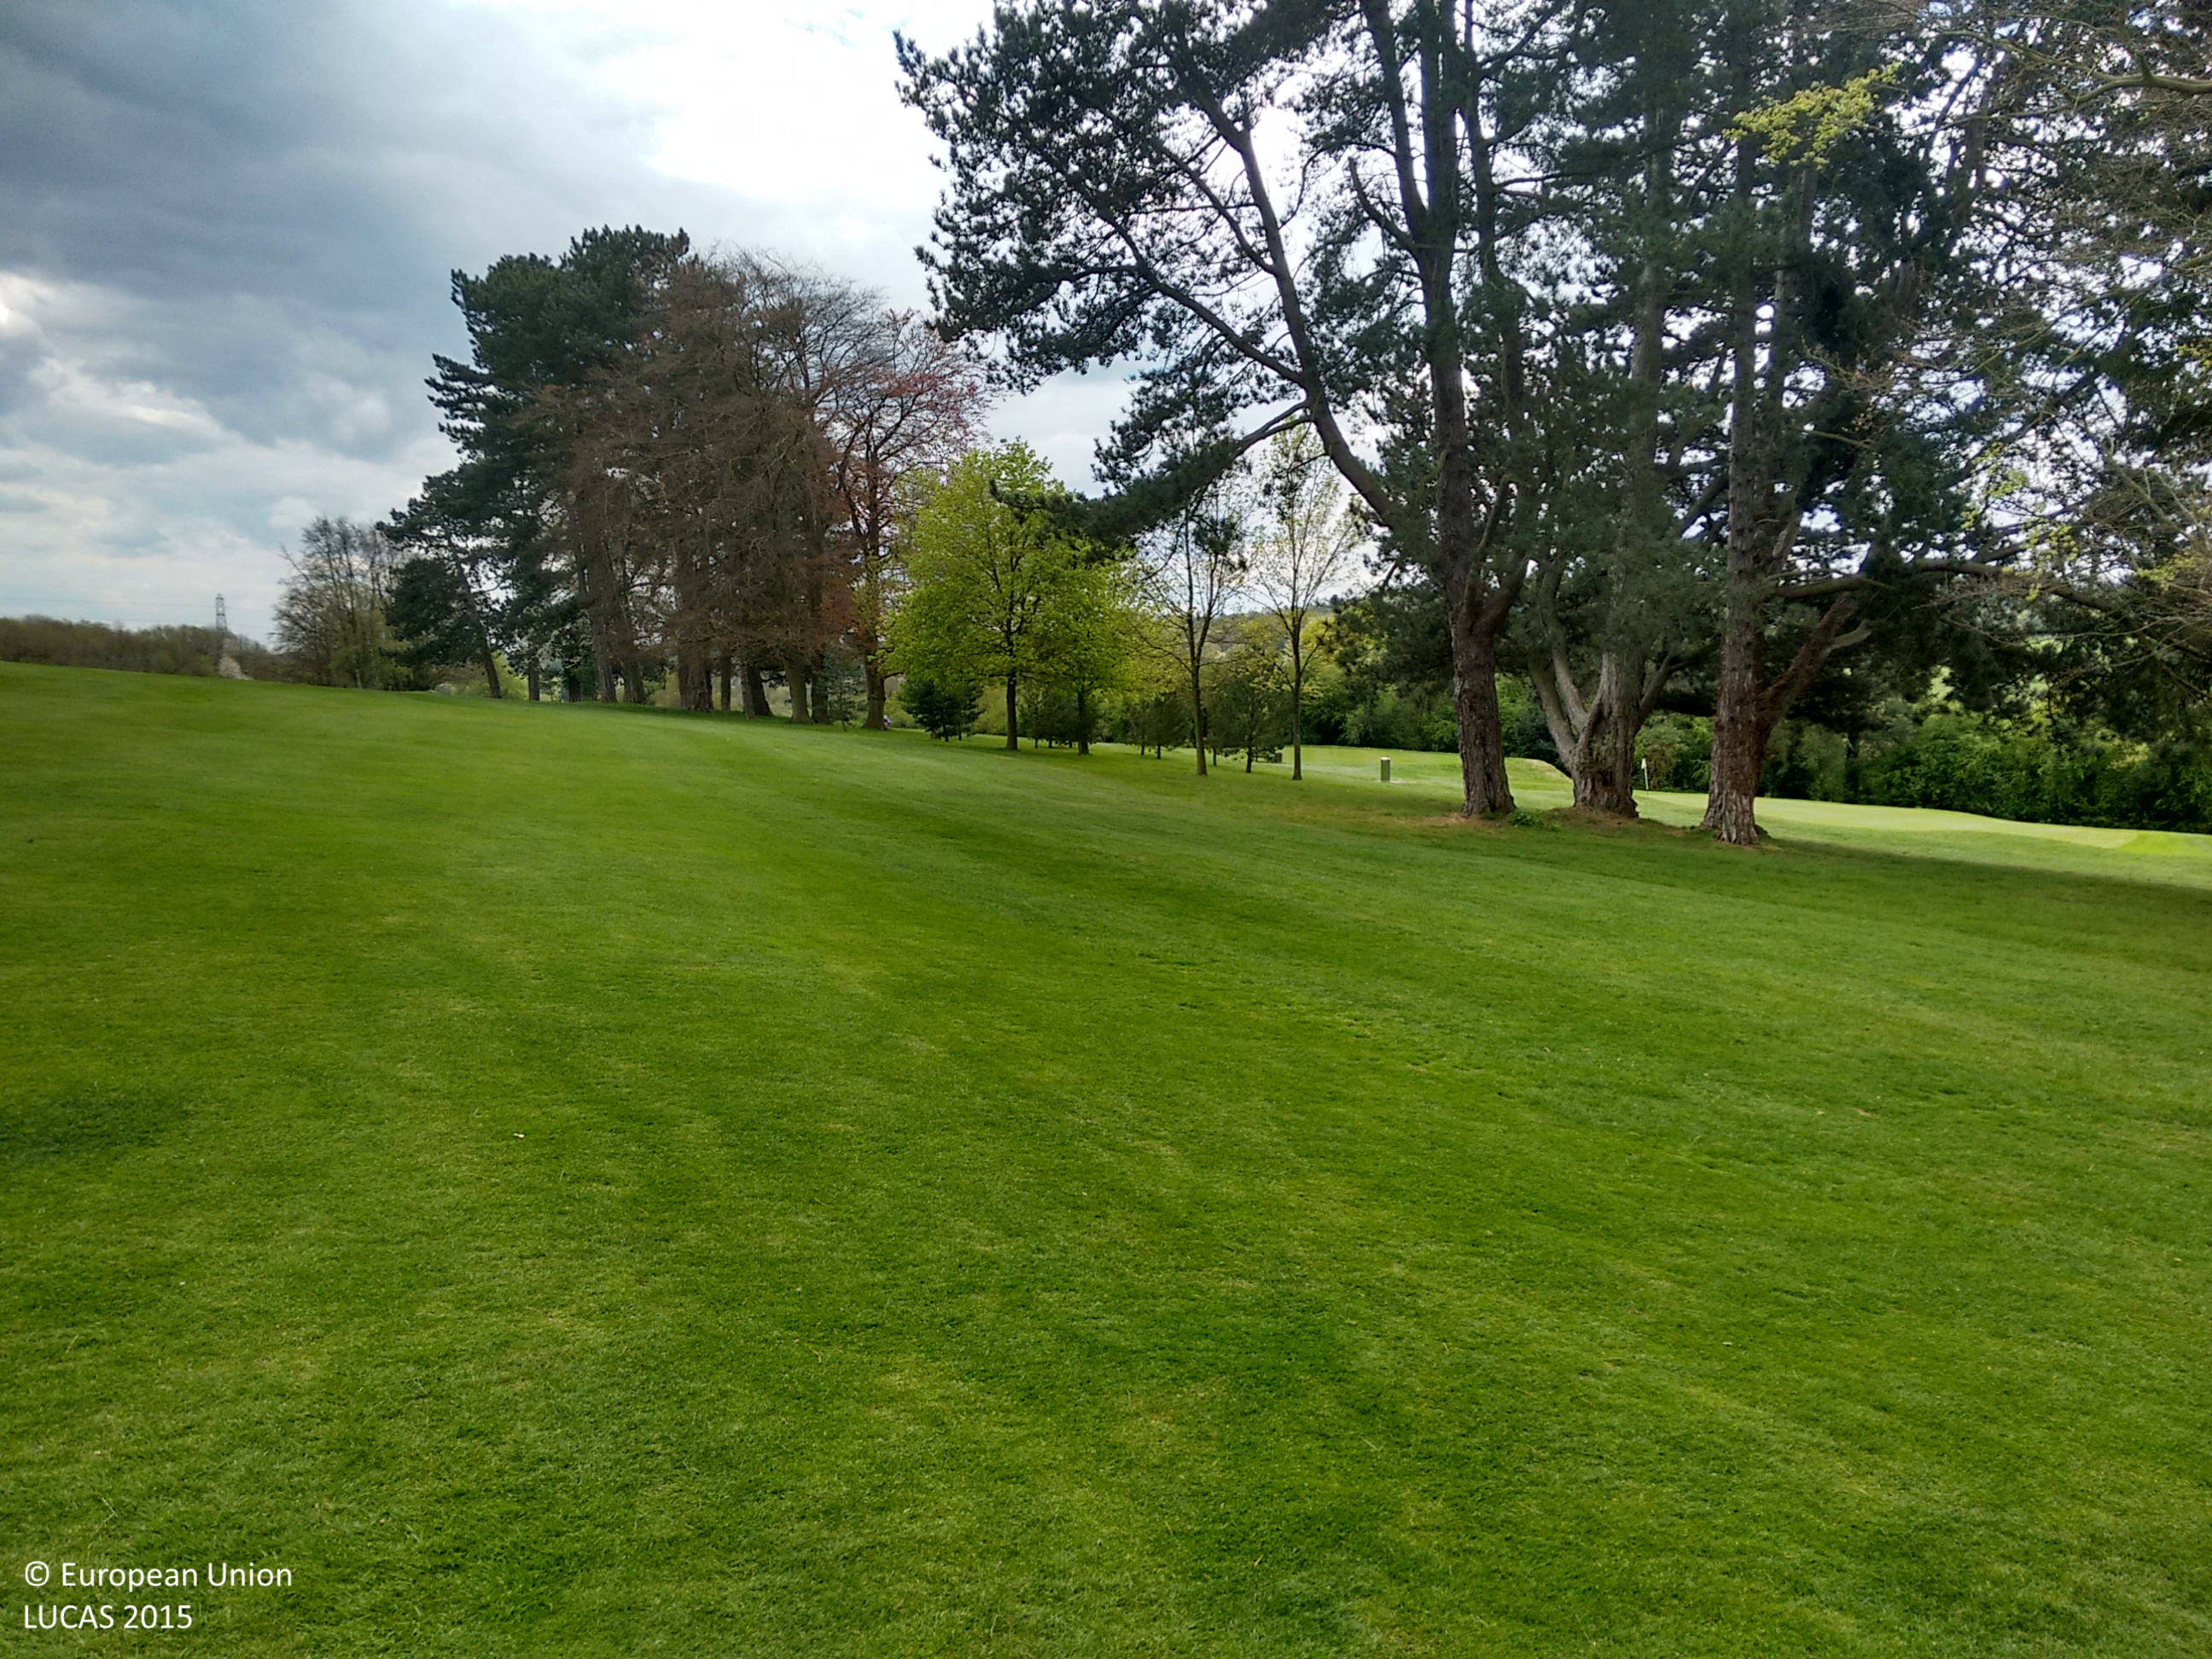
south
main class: Grassland
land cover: Grassland without tree/shrub cover
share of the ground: > 75 %
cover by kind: herbaceous plants 100 %
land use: Sport
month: April
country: GB
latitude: 51.6498
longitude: -0.5755
